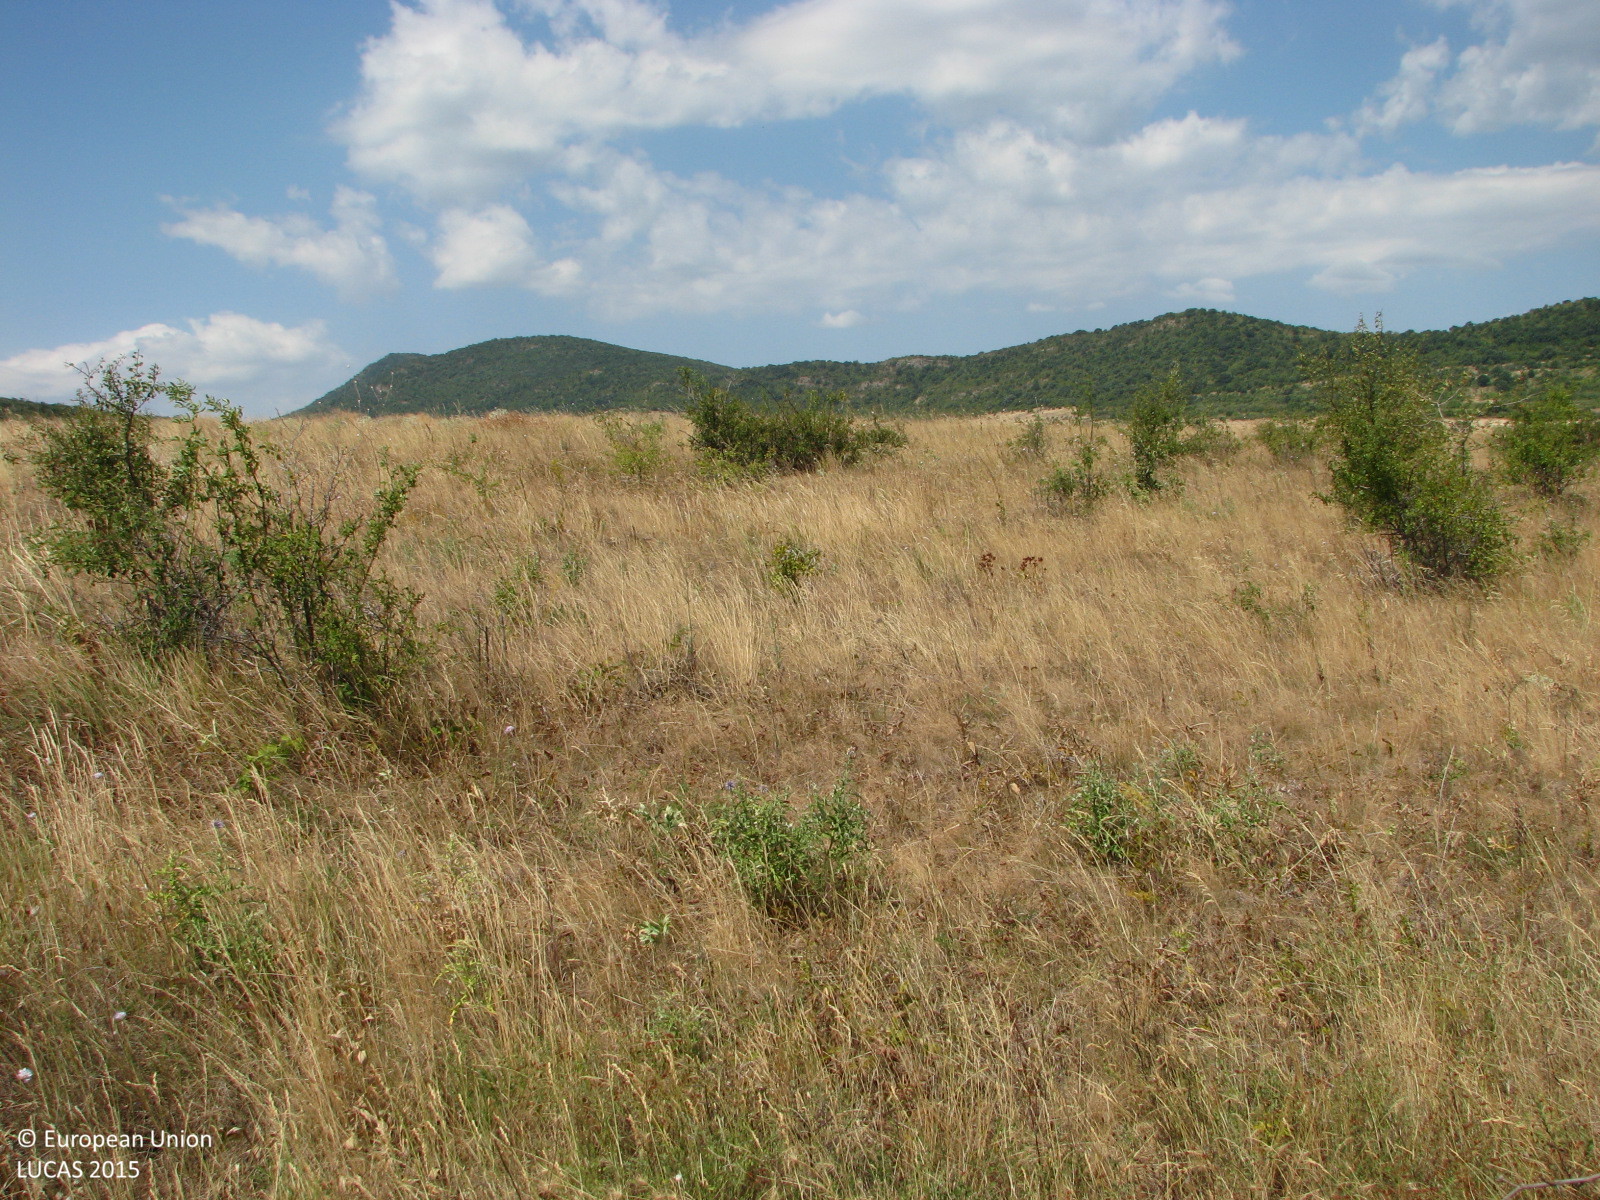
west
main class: Shrubland
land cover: Shrubland without tree cover
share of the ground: 10 - 25 %
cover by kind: herbaceous plants 80 %, shrubs 20 %
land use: Agriculture (excluding fallow land and kitchen gardens)
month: August
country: BG
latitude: 42.6877
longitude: 26.6109
